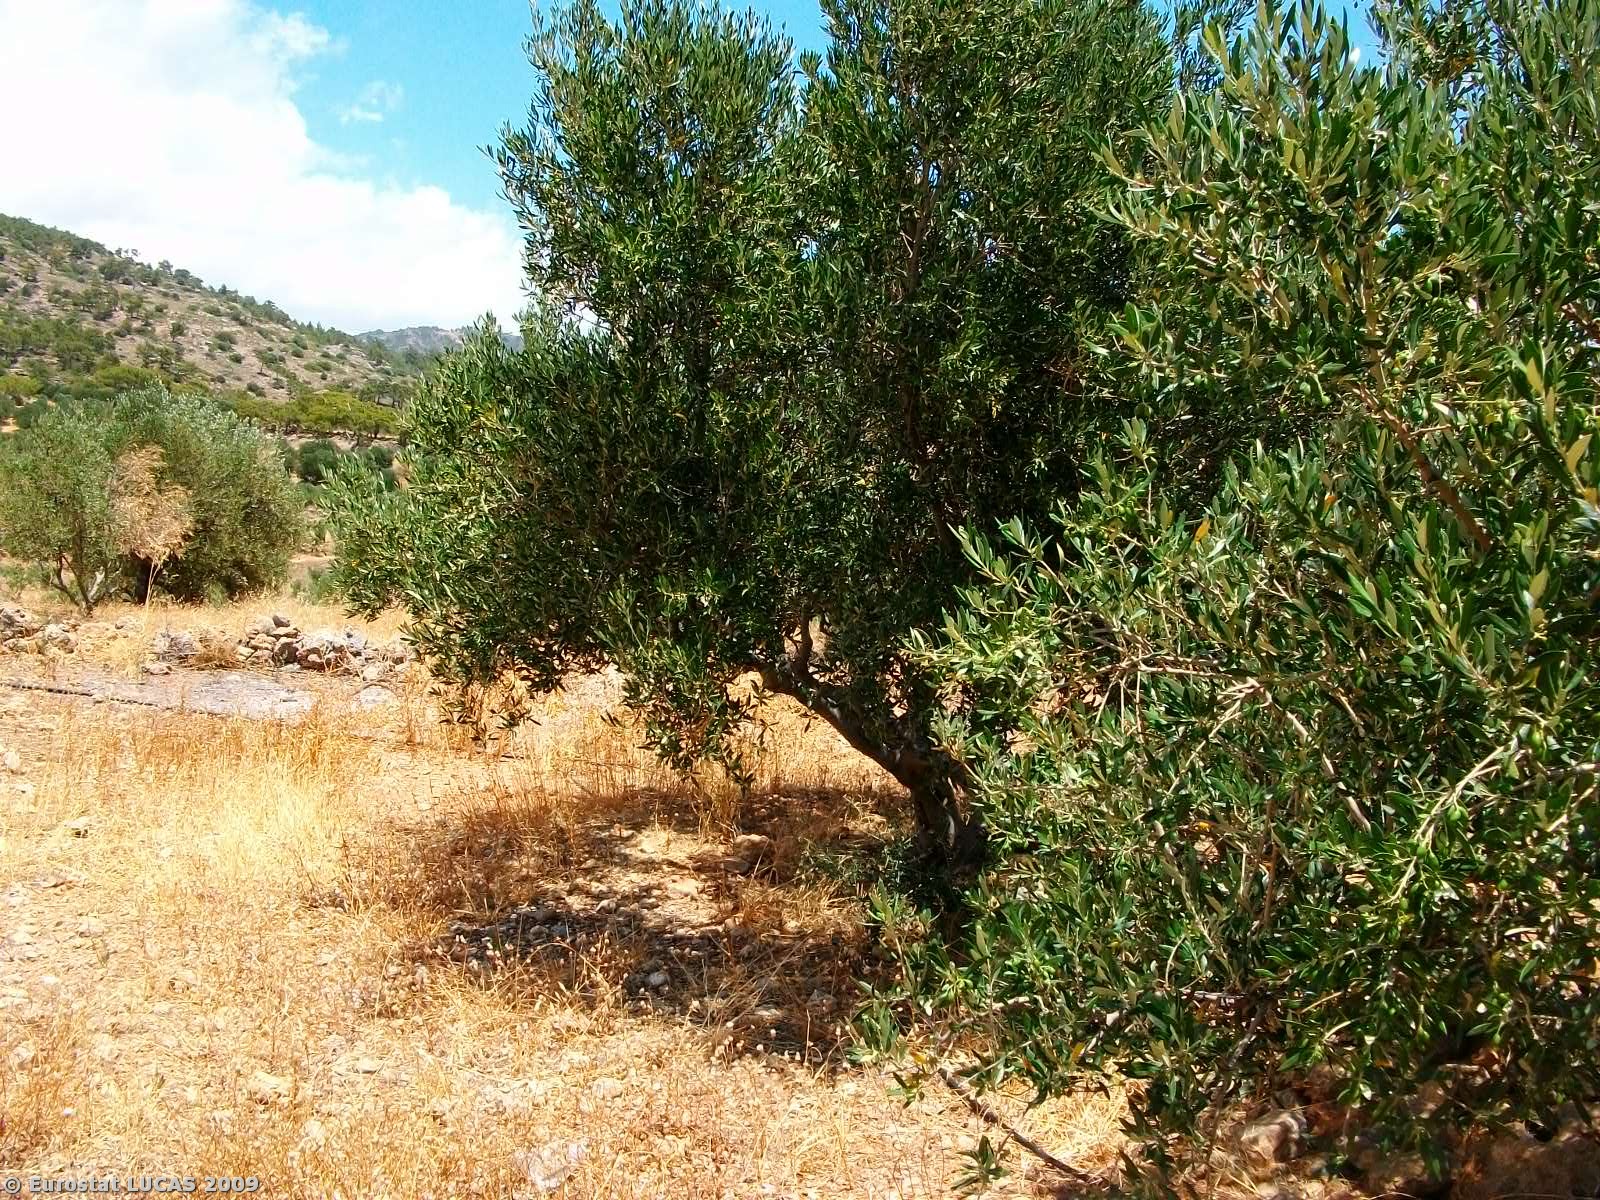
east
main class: Cropland
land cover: Olive groves
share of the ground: 25 - 50 %
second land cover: Bare land
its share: > 75 %
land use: Agriculture (excluding fallow land and kitchen gardens)
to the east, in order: Olive groves; Bare land; Dry stone walls; Olive groves; Bare land; Abandoned hedges; Olive groves; Bare land; Rivers and streams; Olive groves; Bare land; Abandoned hedges; Olive groves; Bare land; Abandoned hedges; Olive groves; Bare land
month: June
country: GR
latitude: 35.0242
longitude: 25.8544
